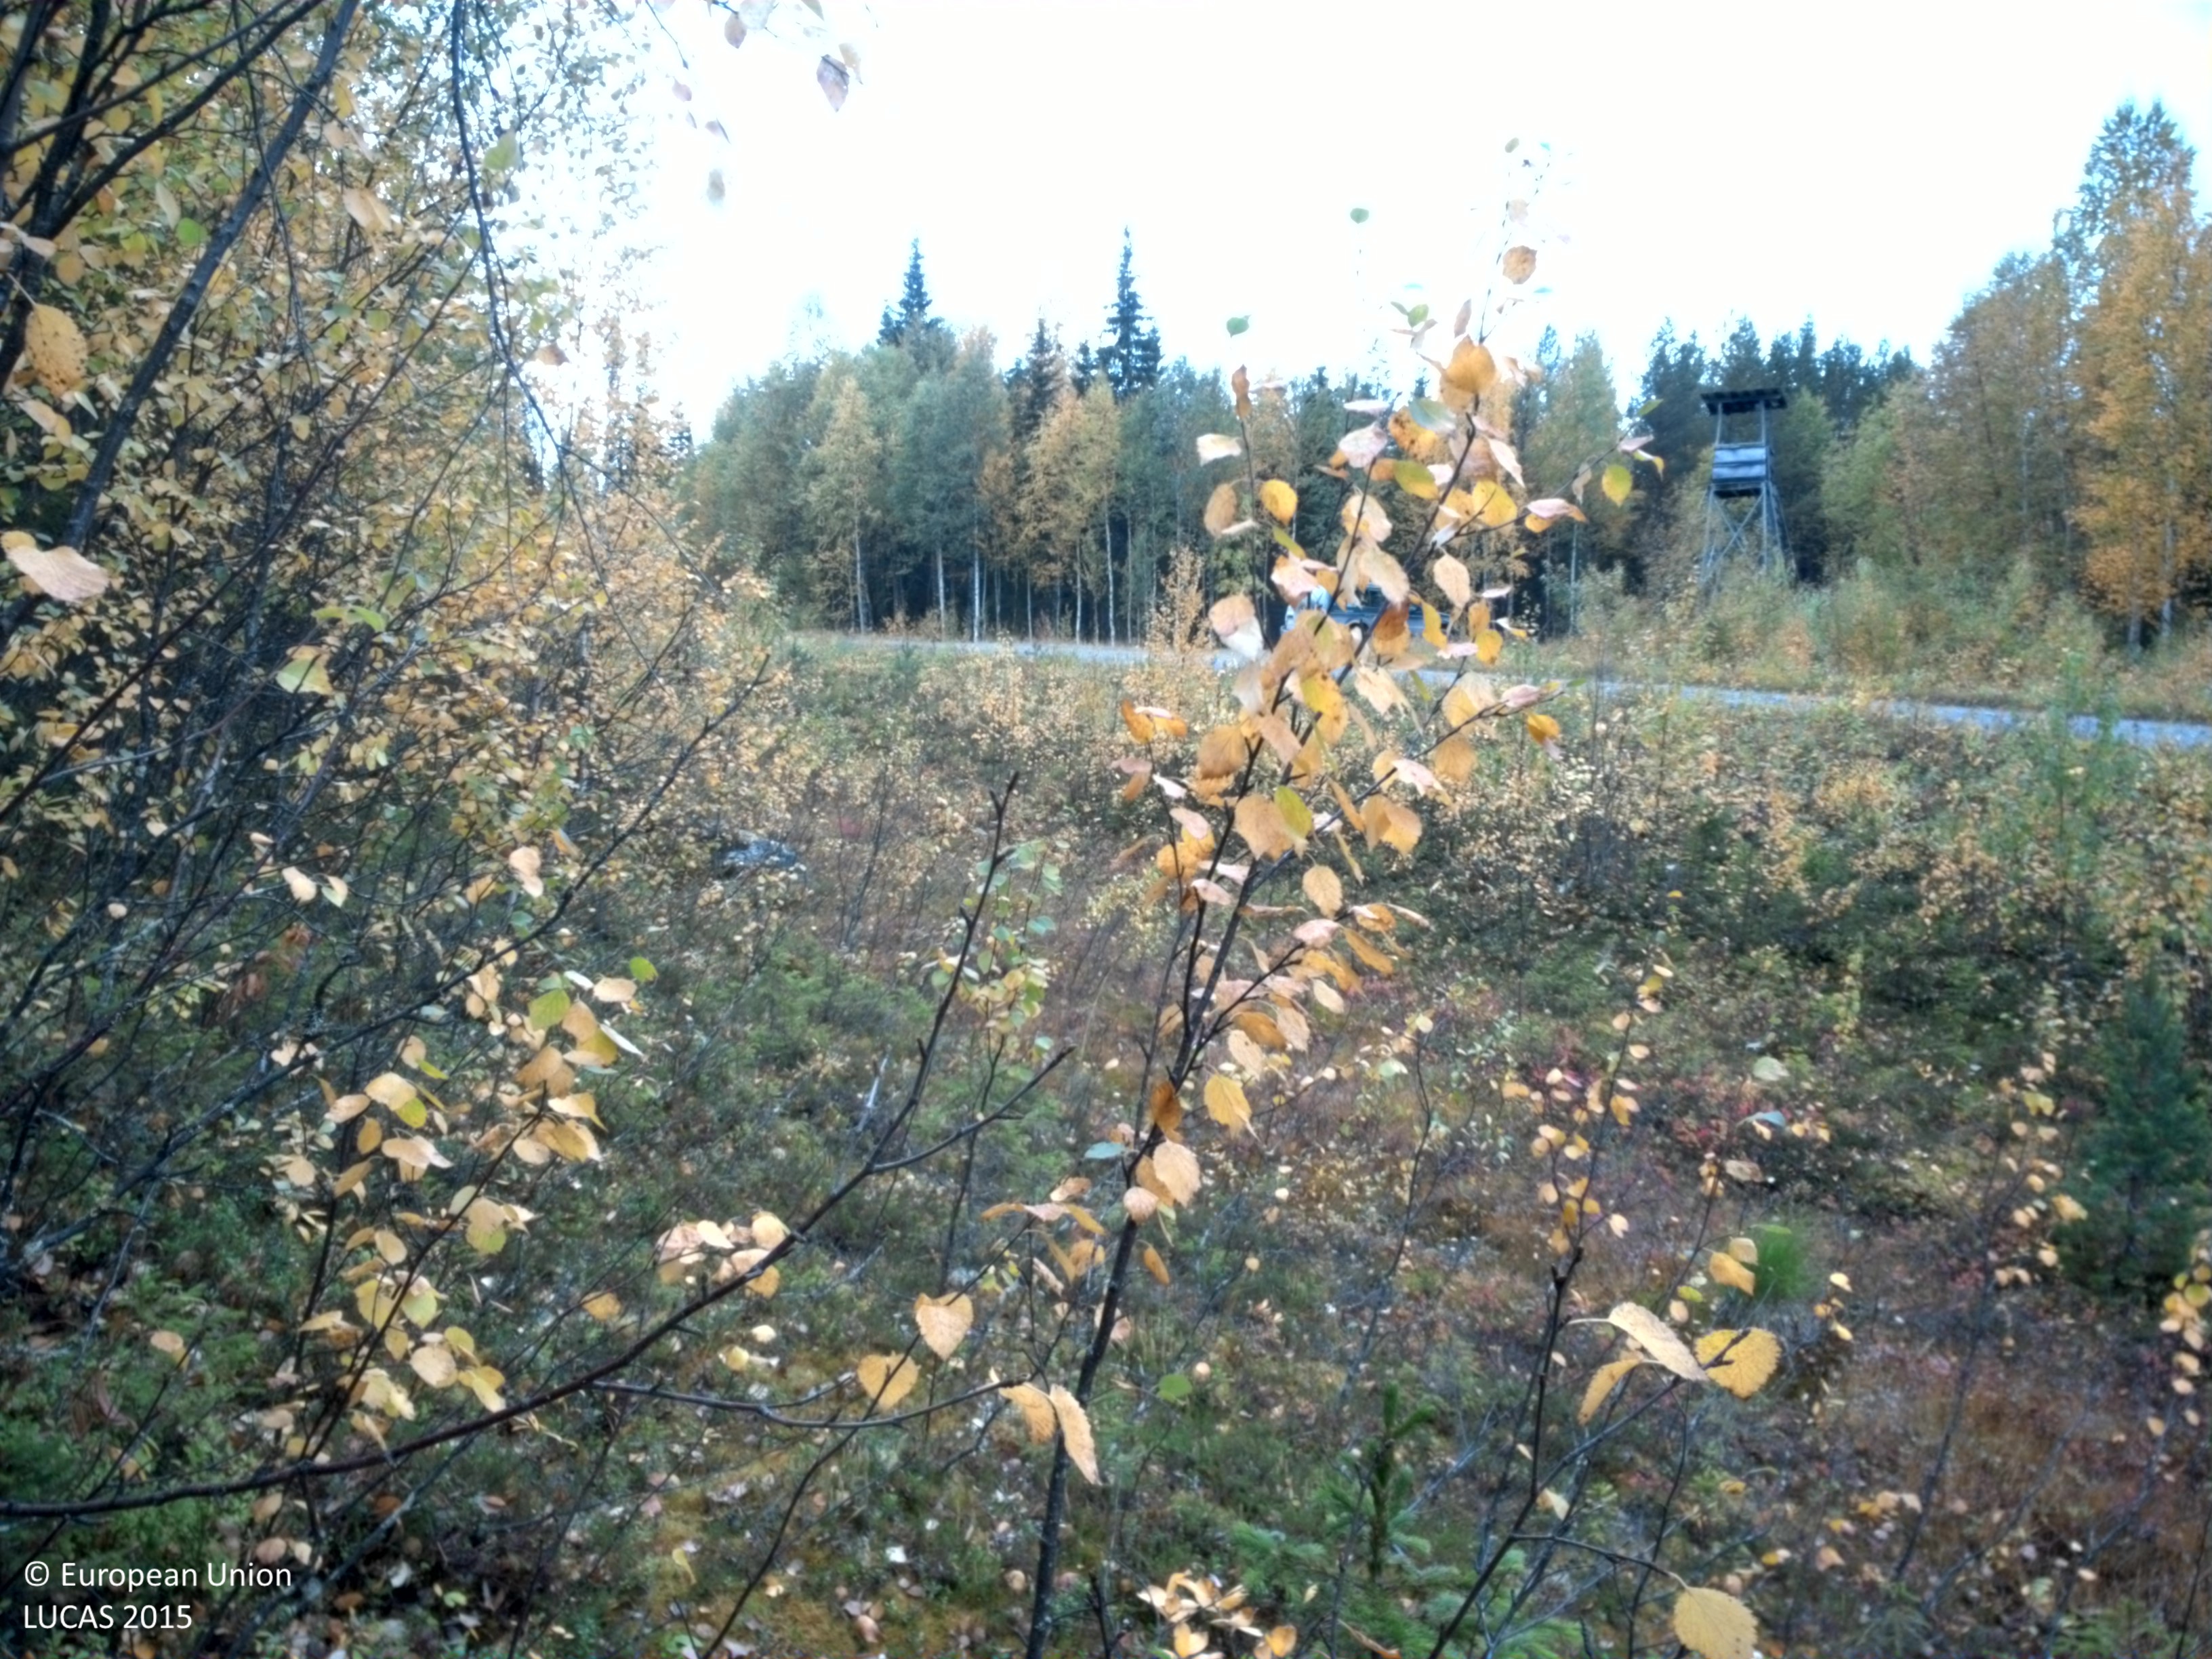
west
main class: Woodland
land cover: Broadleaved woodland
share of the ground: 50 - 75 %
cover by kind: broadleaved forest trees 50 %, shrubs 25 %, herbaceous plants 10 %, lichens and mosses 10 %, coniferous forest trees 5 %
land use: Forestry
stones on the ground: < 10 %
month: September
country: SE
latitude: 65.3606
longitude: 16.3044
